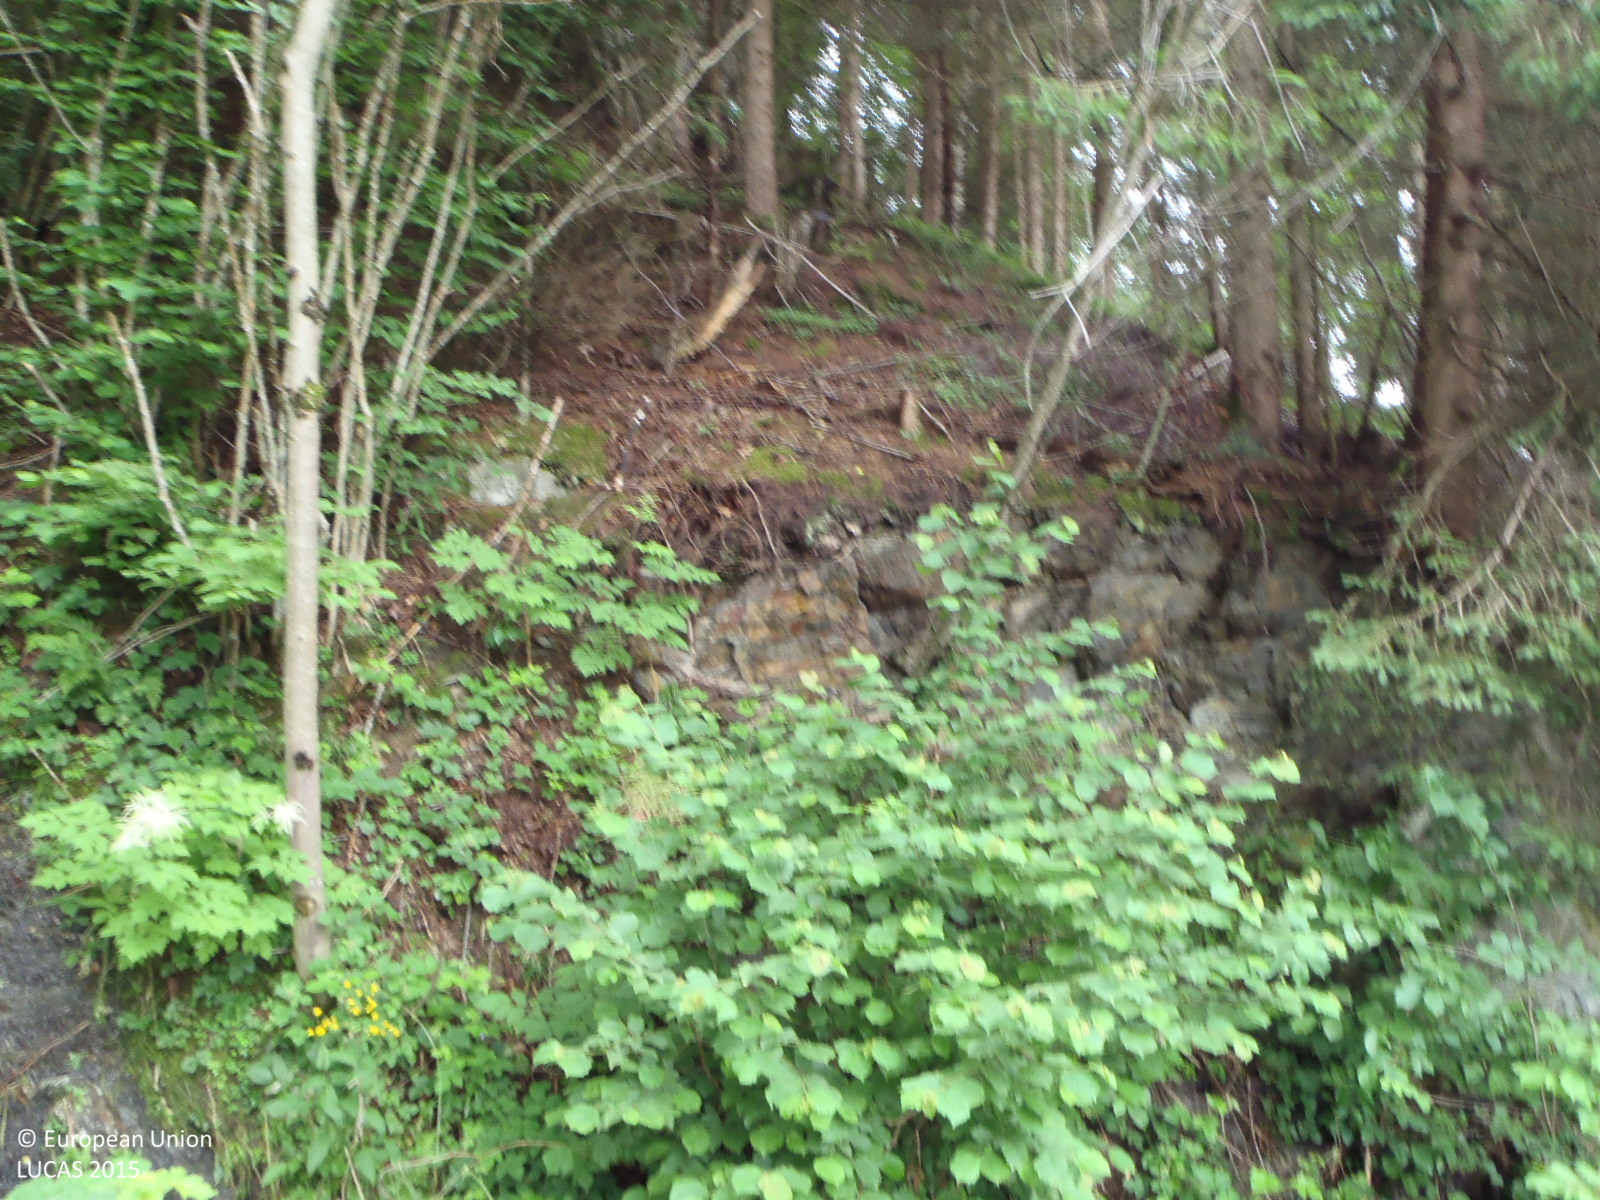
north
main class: Woodland
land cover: Broadleaved woodland
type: mountainous beech forest
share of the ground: 50 - 75 %
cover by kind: broadleaved forest trees 60 %, shrubs 20 %, coniferous forest trees 10 %, herbaceous plants 10 %
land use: Forestry
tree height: > 5 m
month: June
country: AT
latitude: 47.3058
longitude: 12.7889
